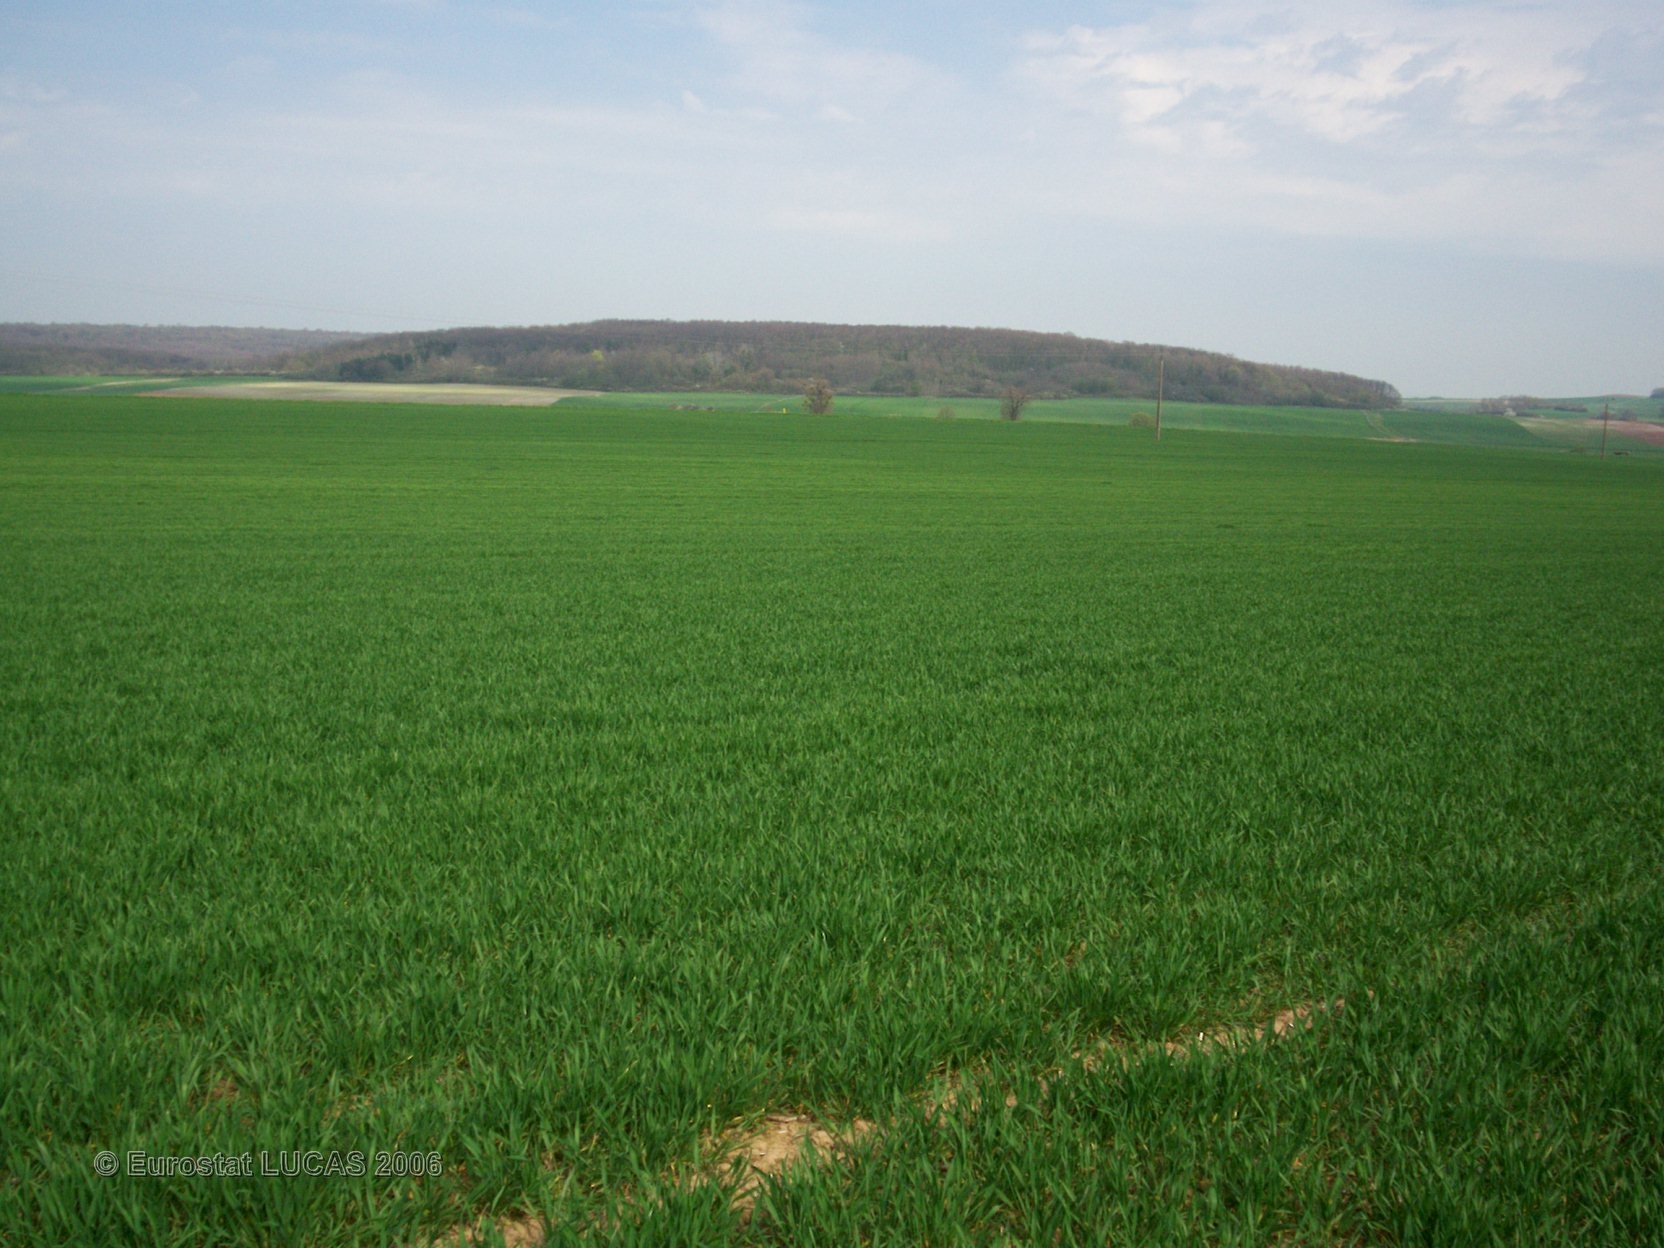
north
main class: Cropland
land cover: Common wheat
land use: Agriculture (excluding fallow land and kitchen gardens)
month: April
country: FR
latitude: 48.7274
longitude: 6.5337
